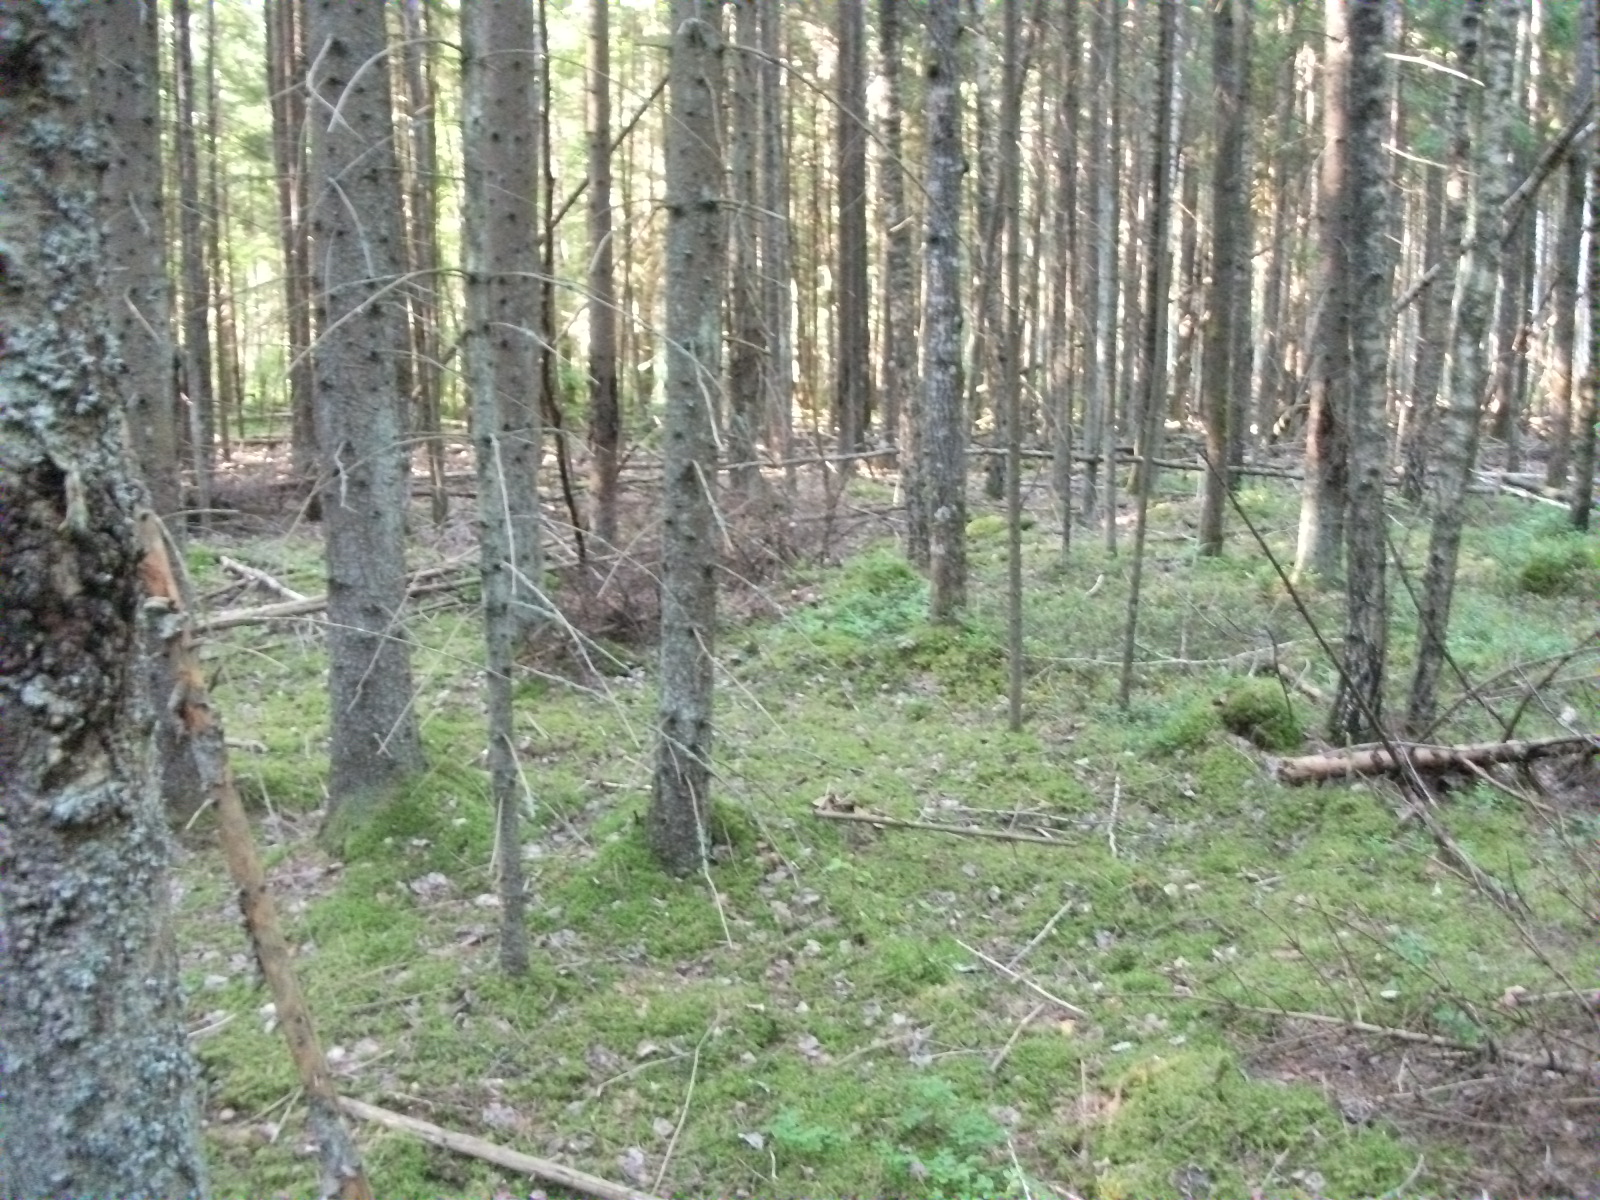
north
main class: Woodland
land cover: Spruce dominated coniferous woodland
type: hemiboreal forest and nemoral coniferous forest and mixed broadleaved-coniferous forest
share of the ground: > 75 %
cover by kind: coniferous forest trees 85 %, shrubs 10 %, broadleaved forest trees 5 %
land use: Forestry
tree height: > 5 m
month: July
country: LV
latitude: 56.8193
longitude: 26.6487
